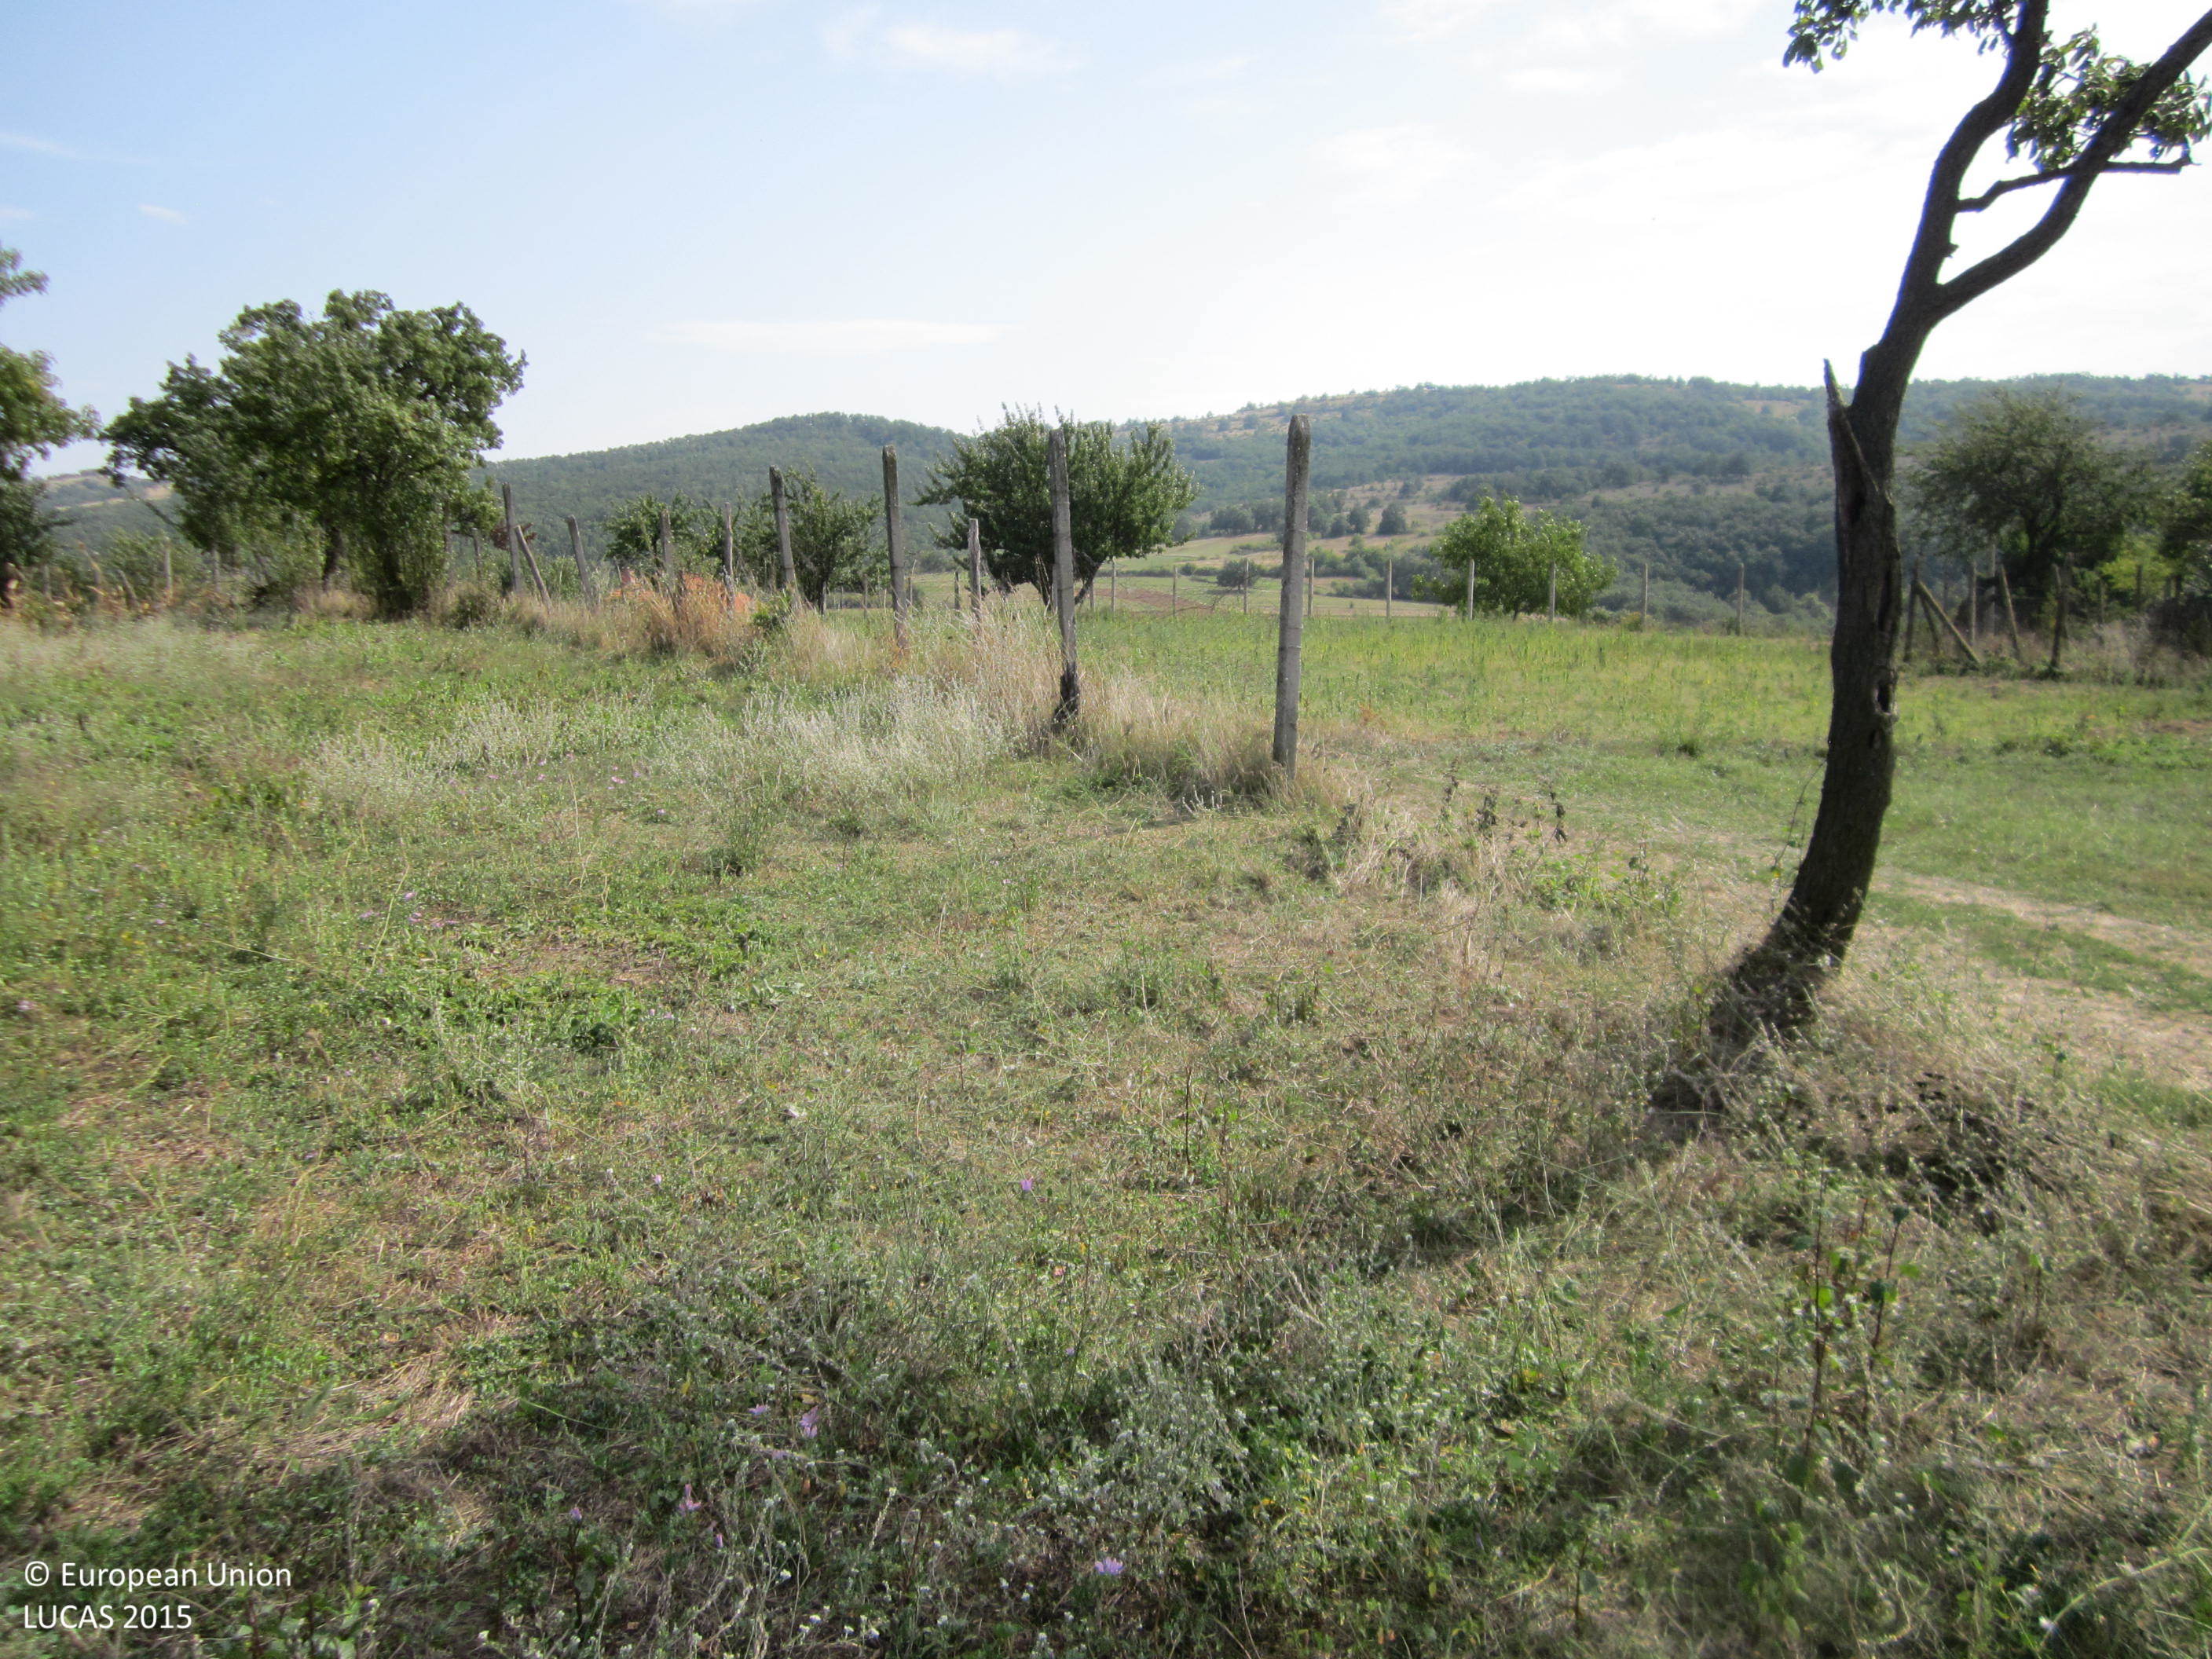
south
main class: Cropland
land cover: Potatoes
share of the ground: 25 - 50 %
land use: Kitchen garden
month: September
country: BG
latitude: 42.7785
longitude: 27.1635
